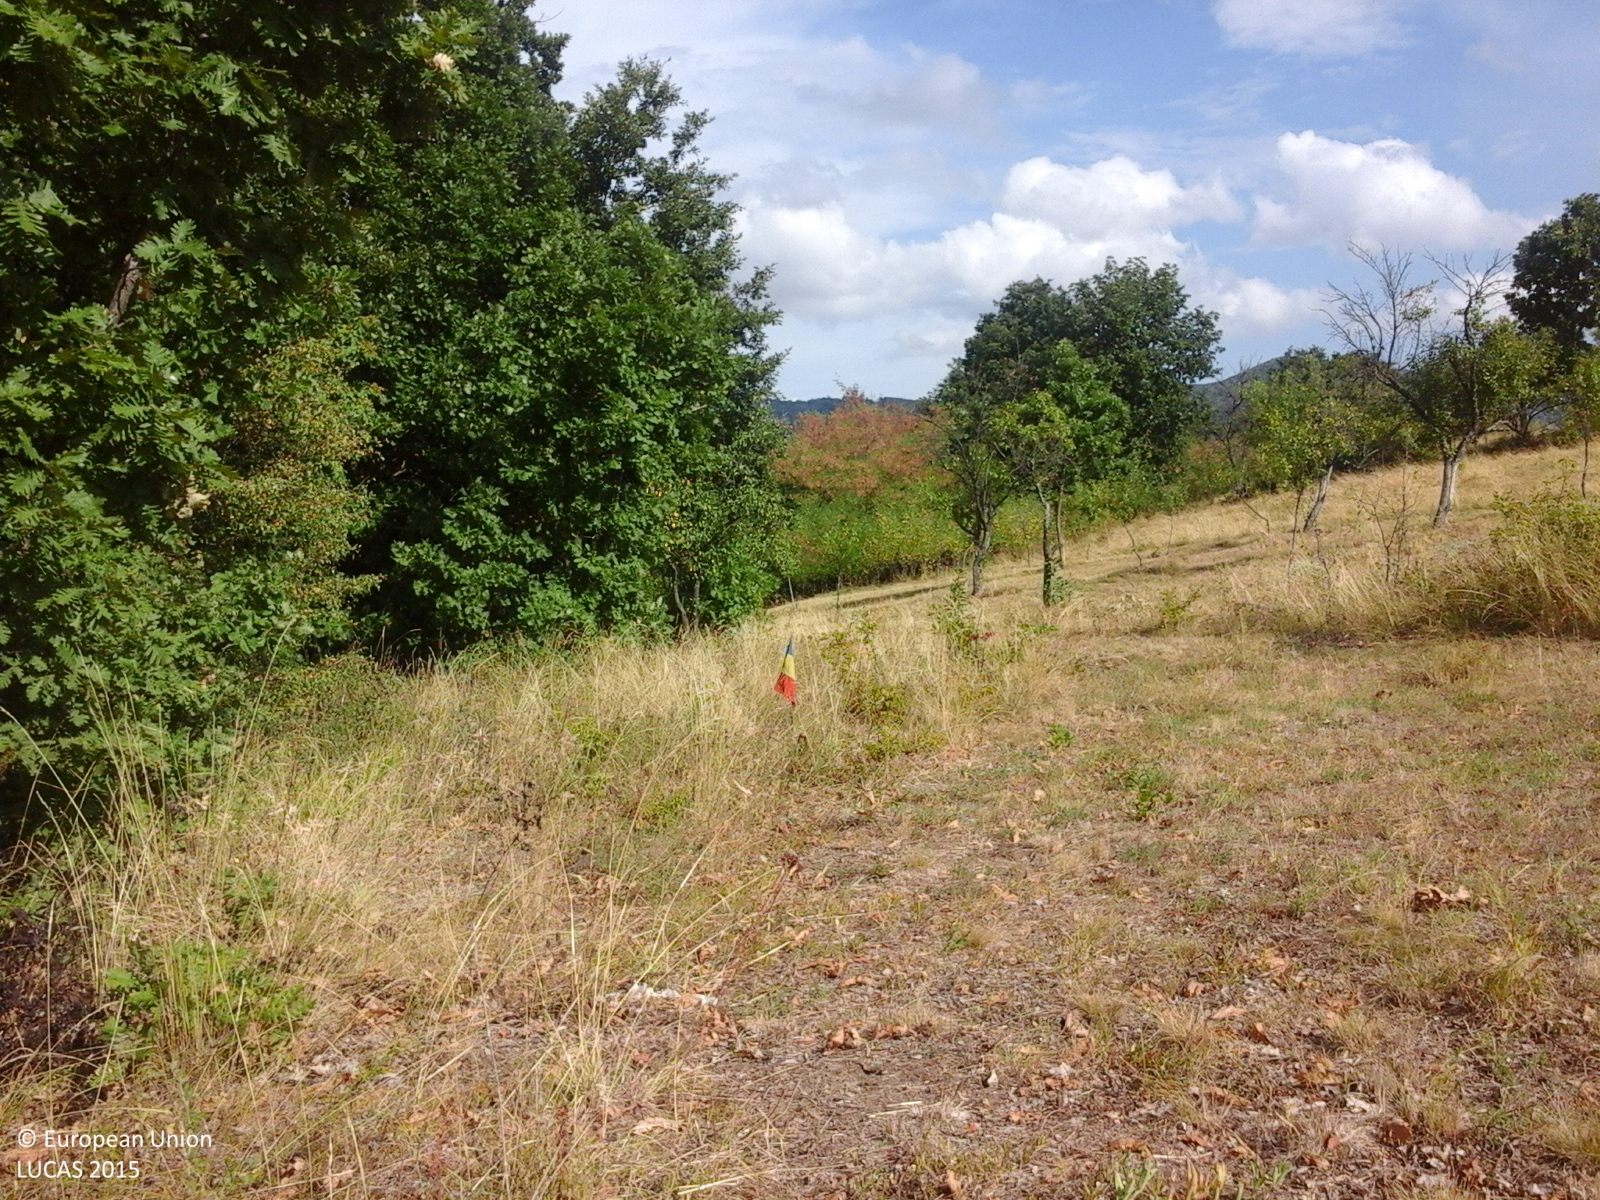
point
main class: Woodland
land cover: Broadleaved woodland
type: acidophilous oak and oak-birch forest
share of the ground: > 75 %
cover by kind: broadleaved forest trees 100 %
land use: Forestry
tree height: > 5 m
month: August
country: RO
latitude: 44.7632
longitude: 22.4589
